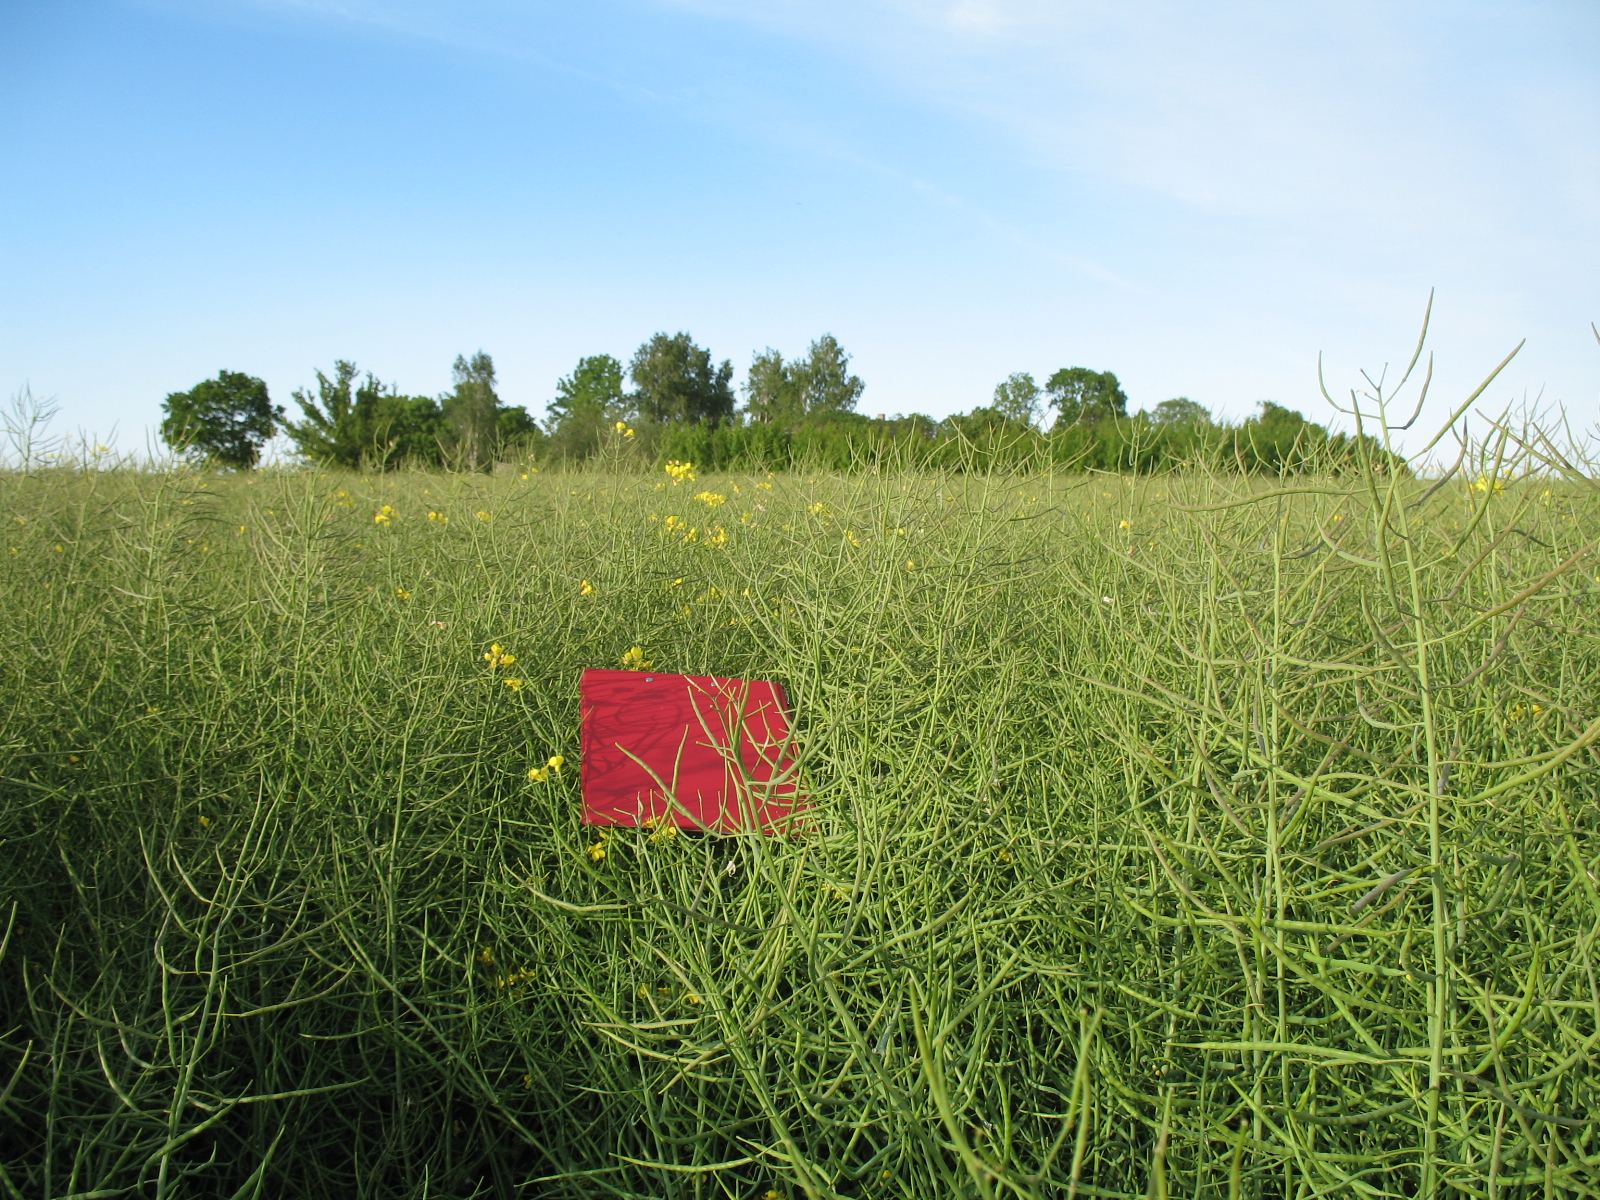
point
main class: Cropland
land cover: Rape and turnip rape
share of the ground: > 75 %
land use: Agriculture (excluding fallow land and kitchen gardens)
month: June
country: LV
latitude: 56.5866
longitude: 23.4747
